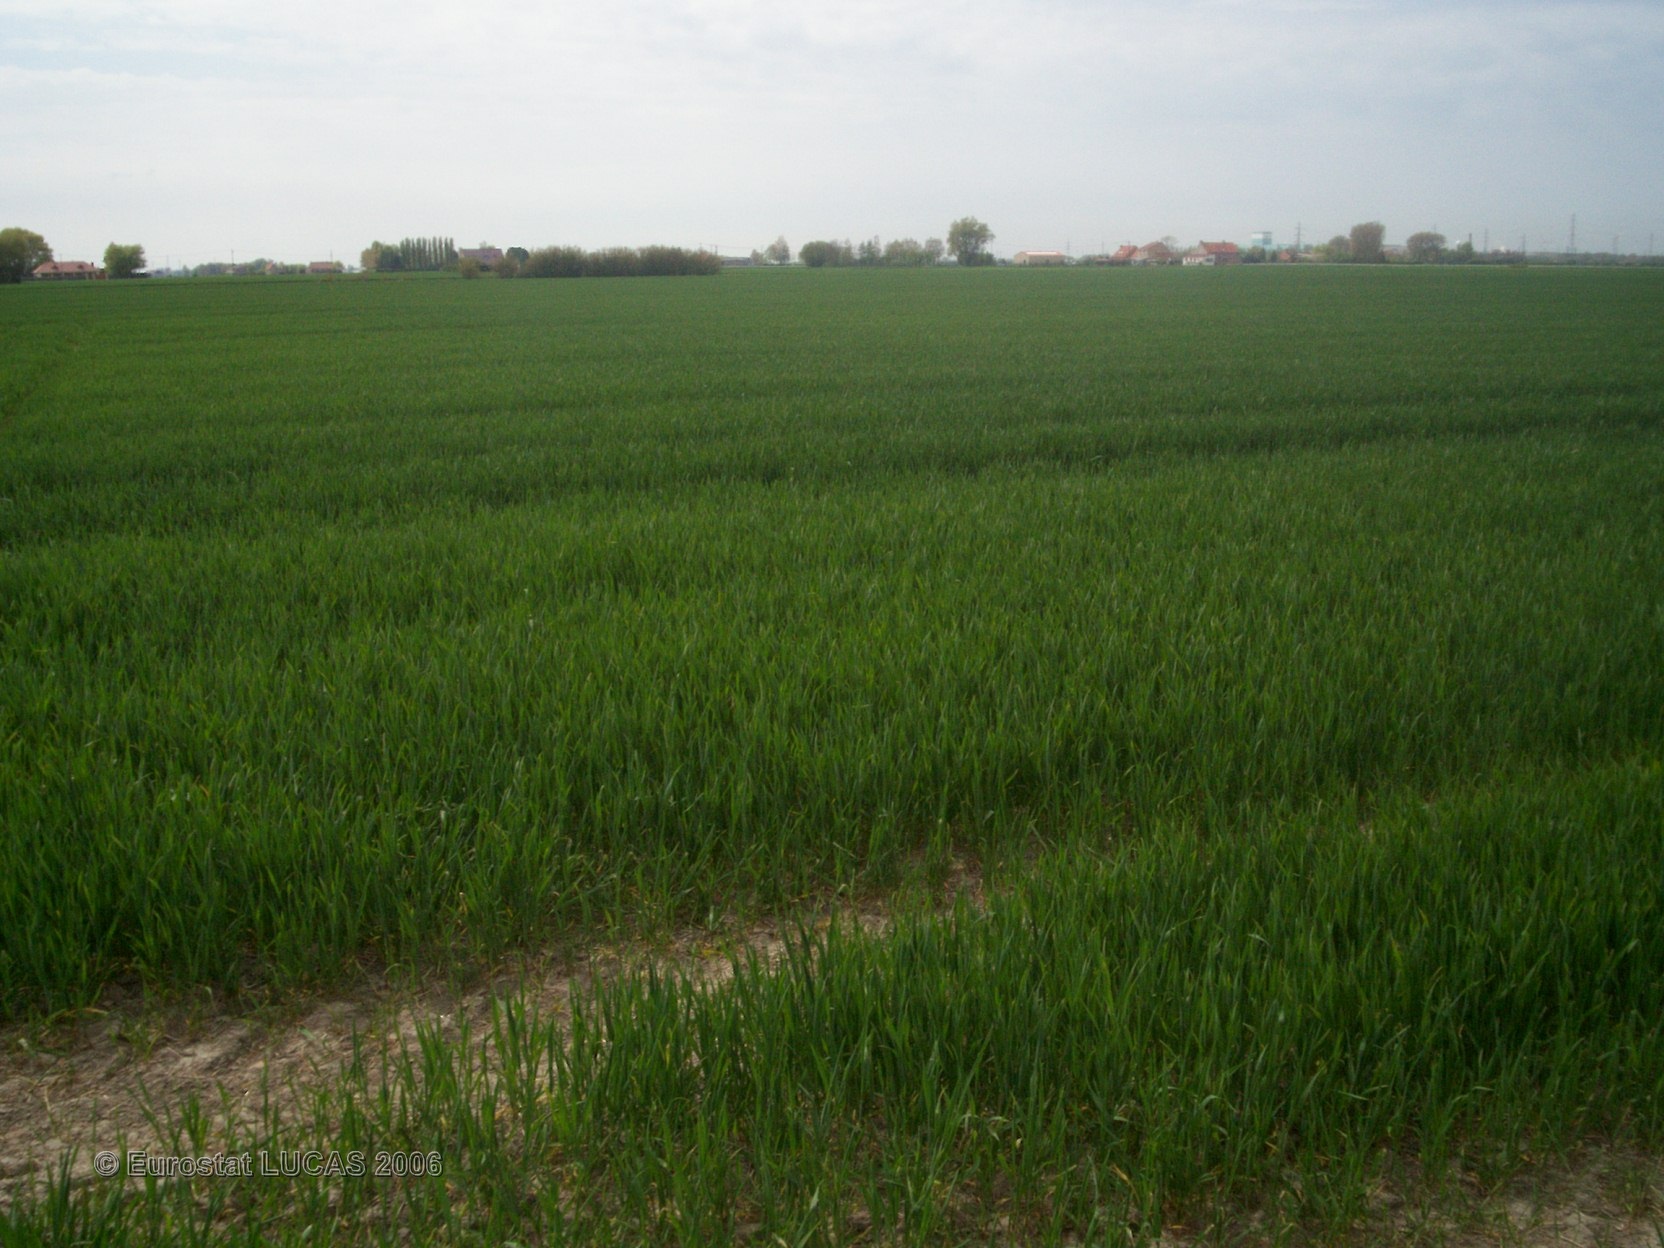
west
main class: Cropland
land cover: Common wheat
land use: Agriculture (excluding fallow land and kitchen gardens)
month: May
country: FR
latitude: 50.9739
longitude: 2.3385
